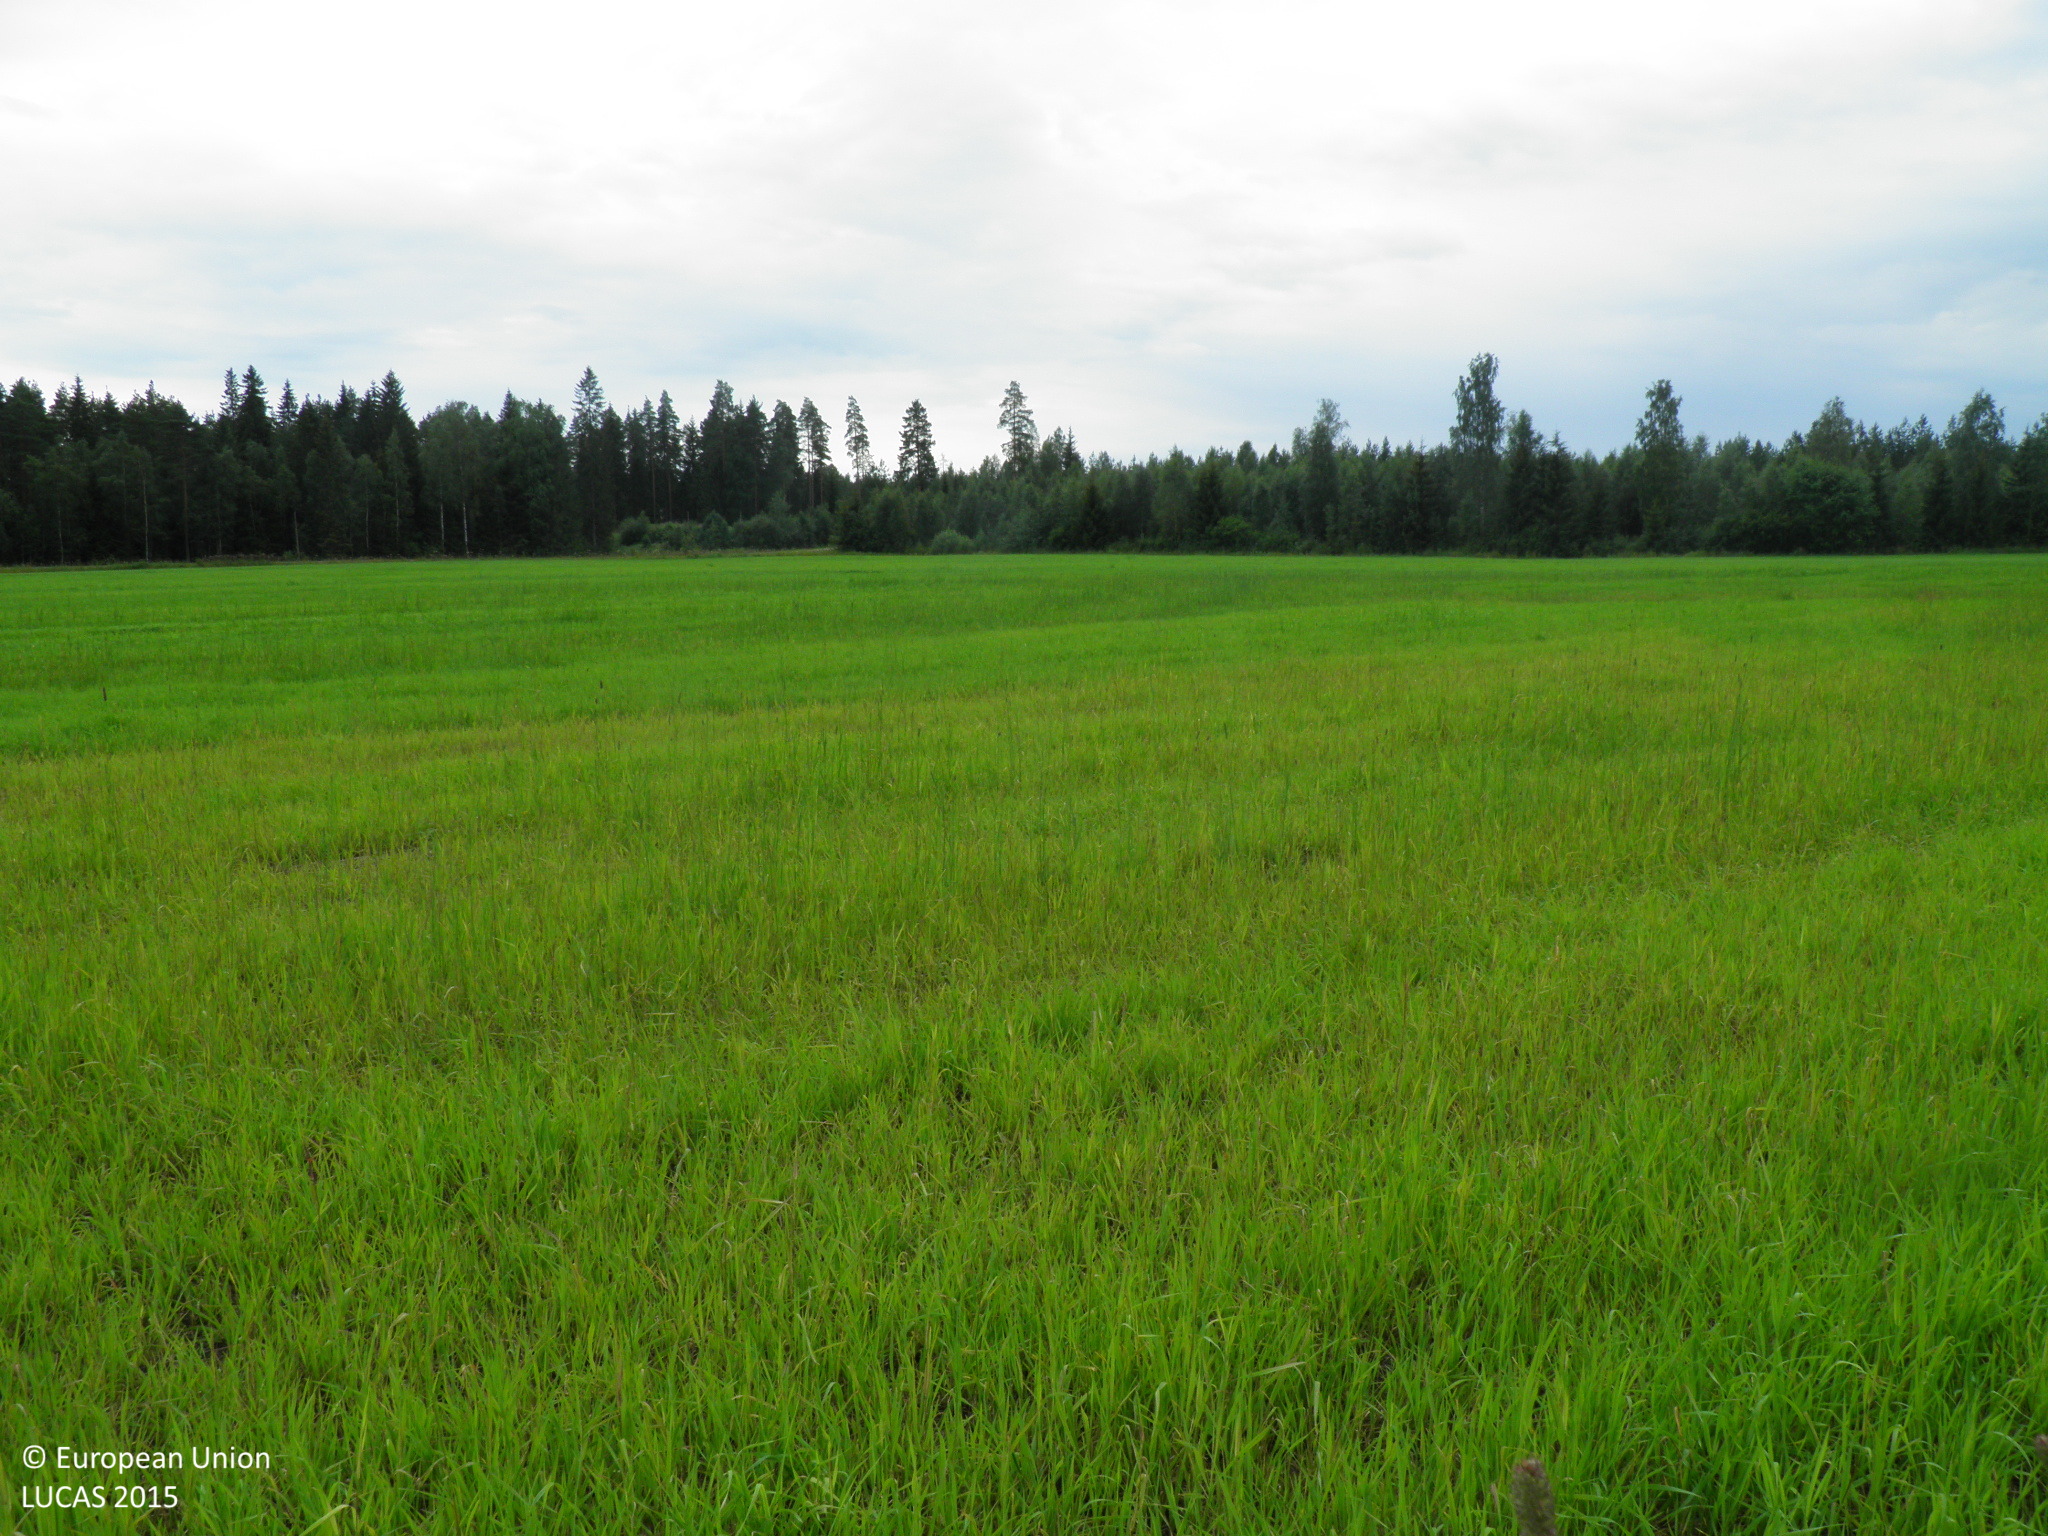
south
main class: Cropland
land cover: Barley
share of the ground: > 75 %
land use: Agriculture (excluding fallow land and kitchen gardens)
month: August
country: FI
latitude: 61.0970
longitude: 22.9638
